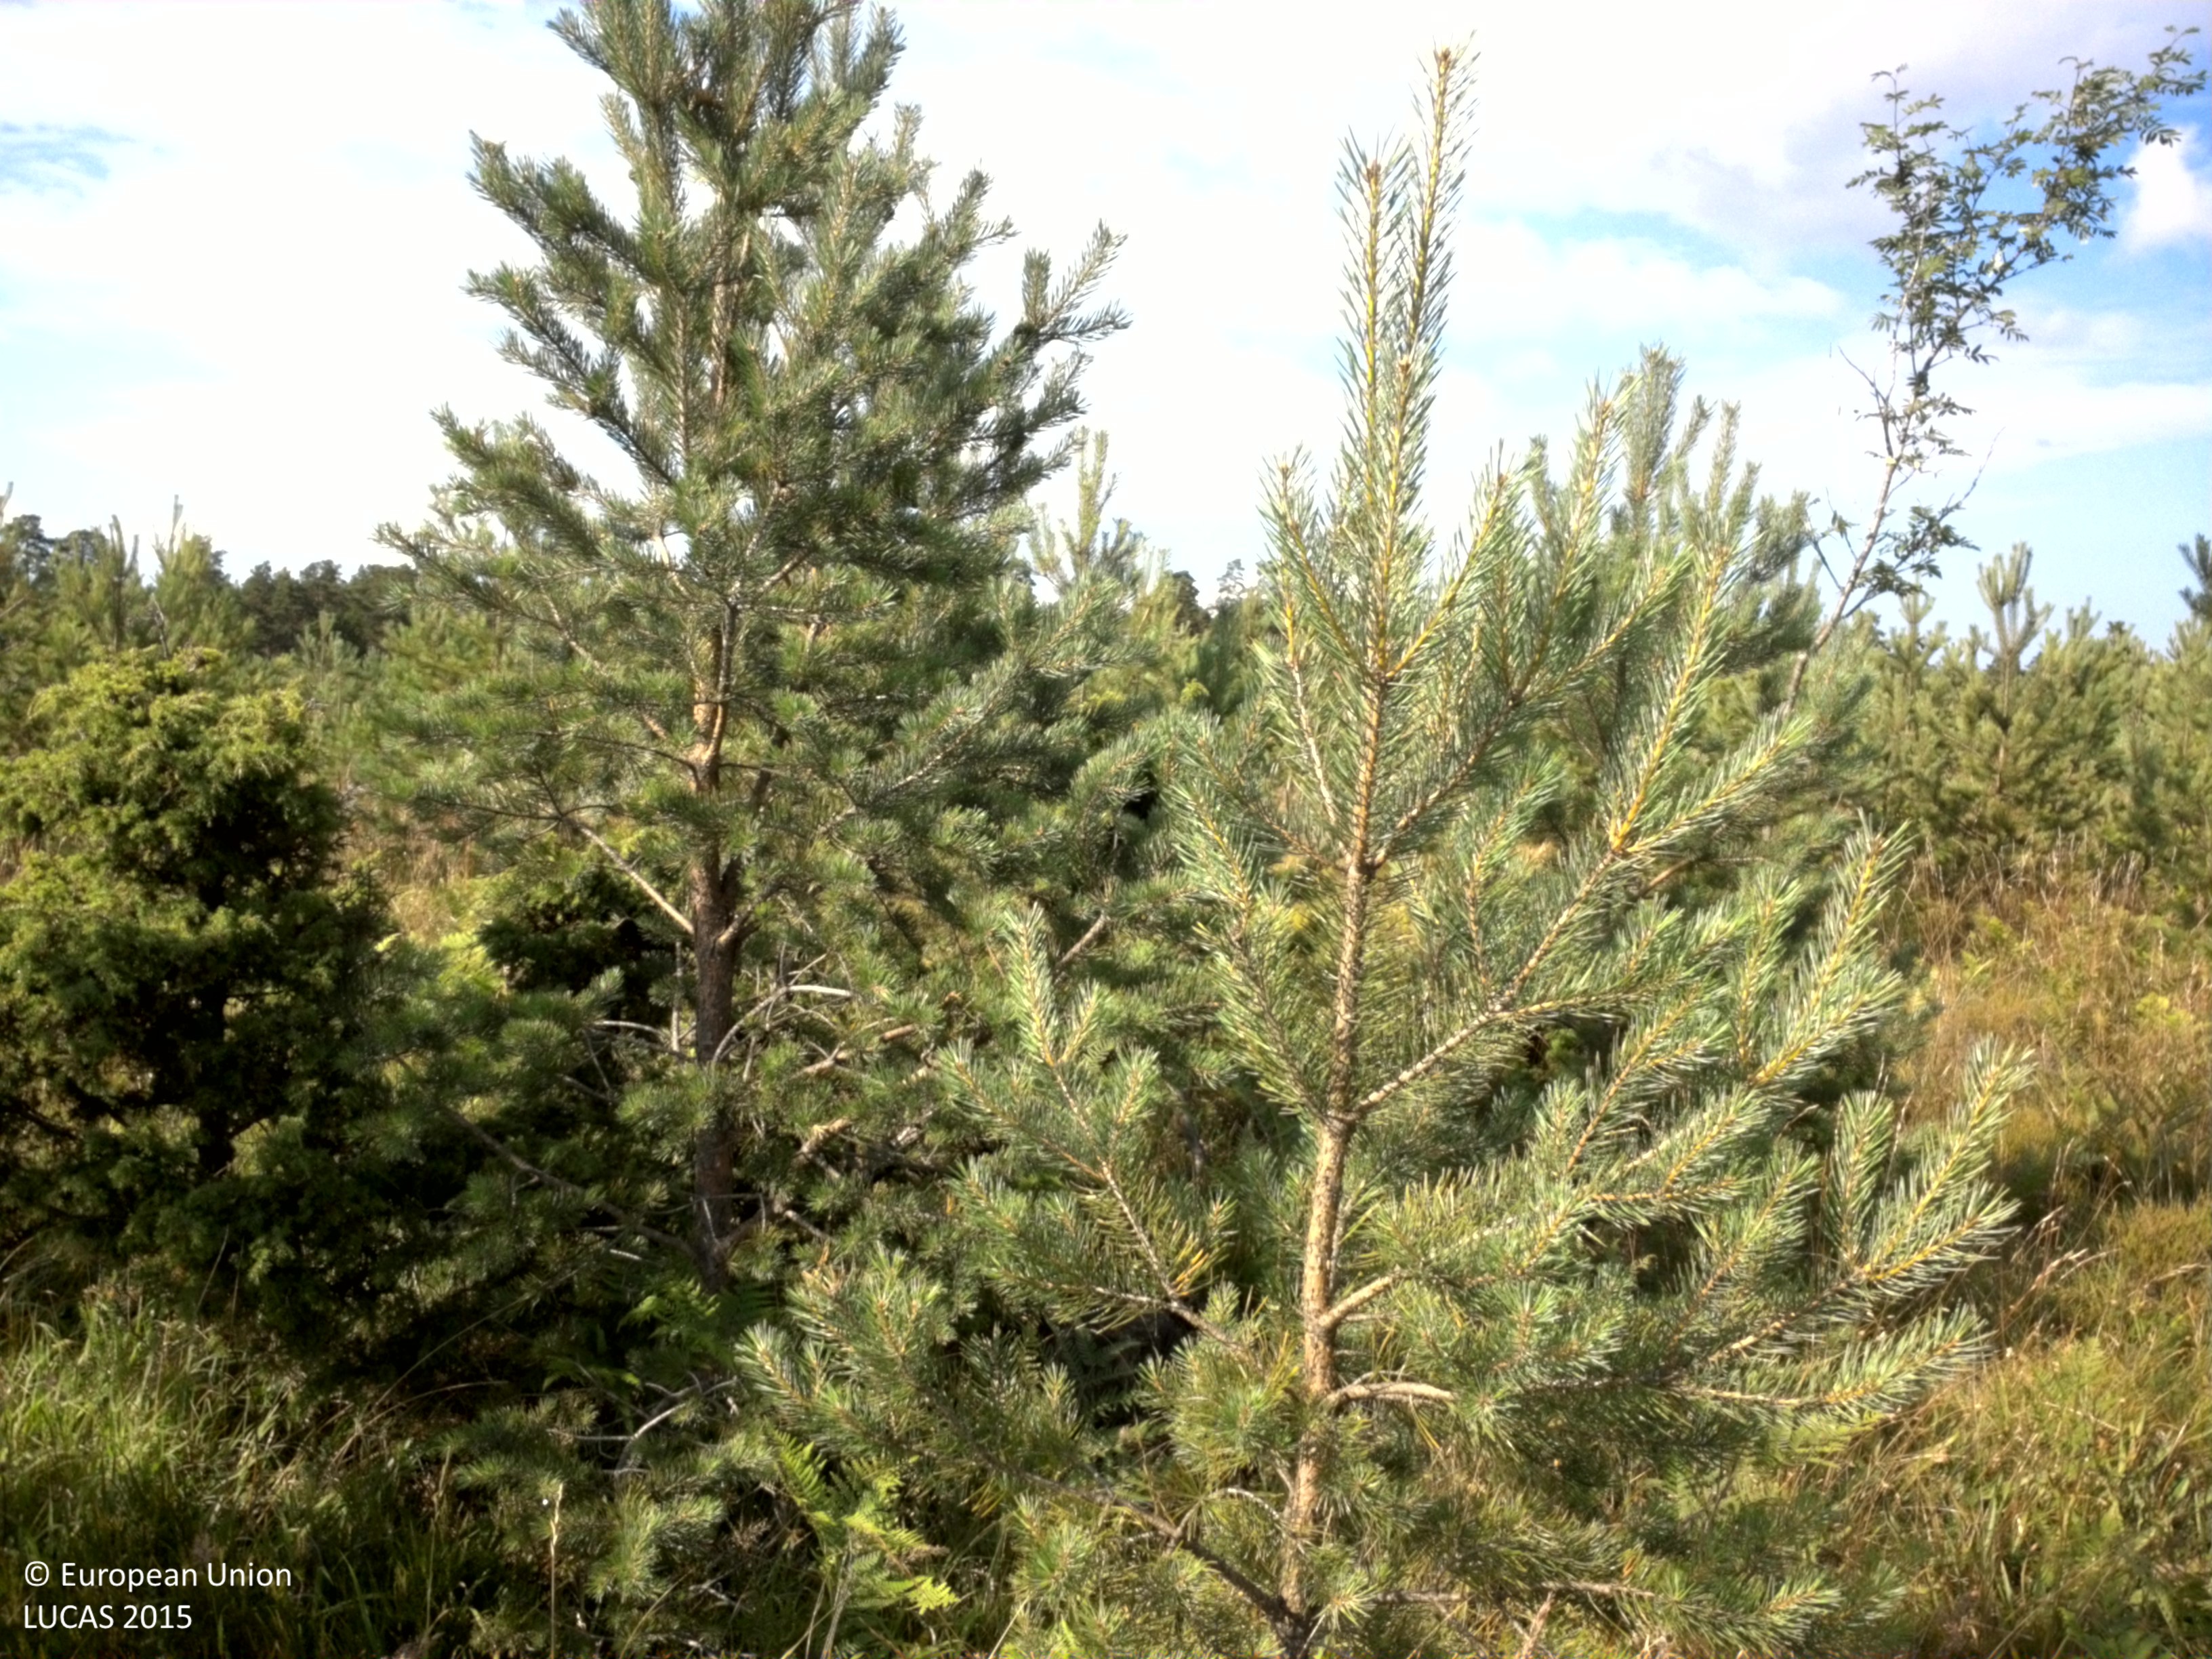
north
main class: Woodland
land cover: Pine dominated coniferous woodland
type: hemiboreal forest and nemoral coniferous forest and mixed broadleaved-coniferous forest
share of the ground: 50 - 75 %
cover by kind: coniferous forest trees 55 %, herbaceous plants 40 %, shrubs 5 %
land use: Forestry
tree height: < 5 m
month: July
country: SE
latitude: 57.4710
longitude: 18.6301
